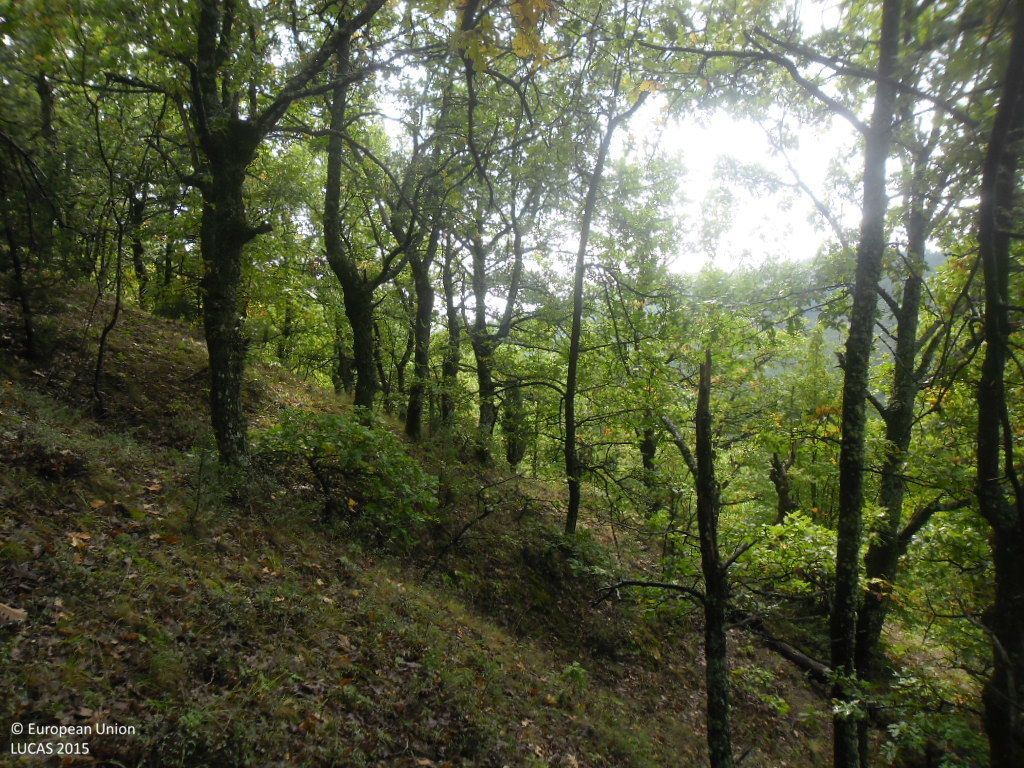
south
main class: Woodland
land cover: Broadleaved woodland
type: mesophytic deciduous forest
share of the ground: > 75 %
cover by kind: broadleaved forest trees 95 %, unconsolidated bare surface 5 %
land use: Forestry
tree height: > 5 m
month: October
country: BG
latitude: 41.9345
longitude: 23.1825
